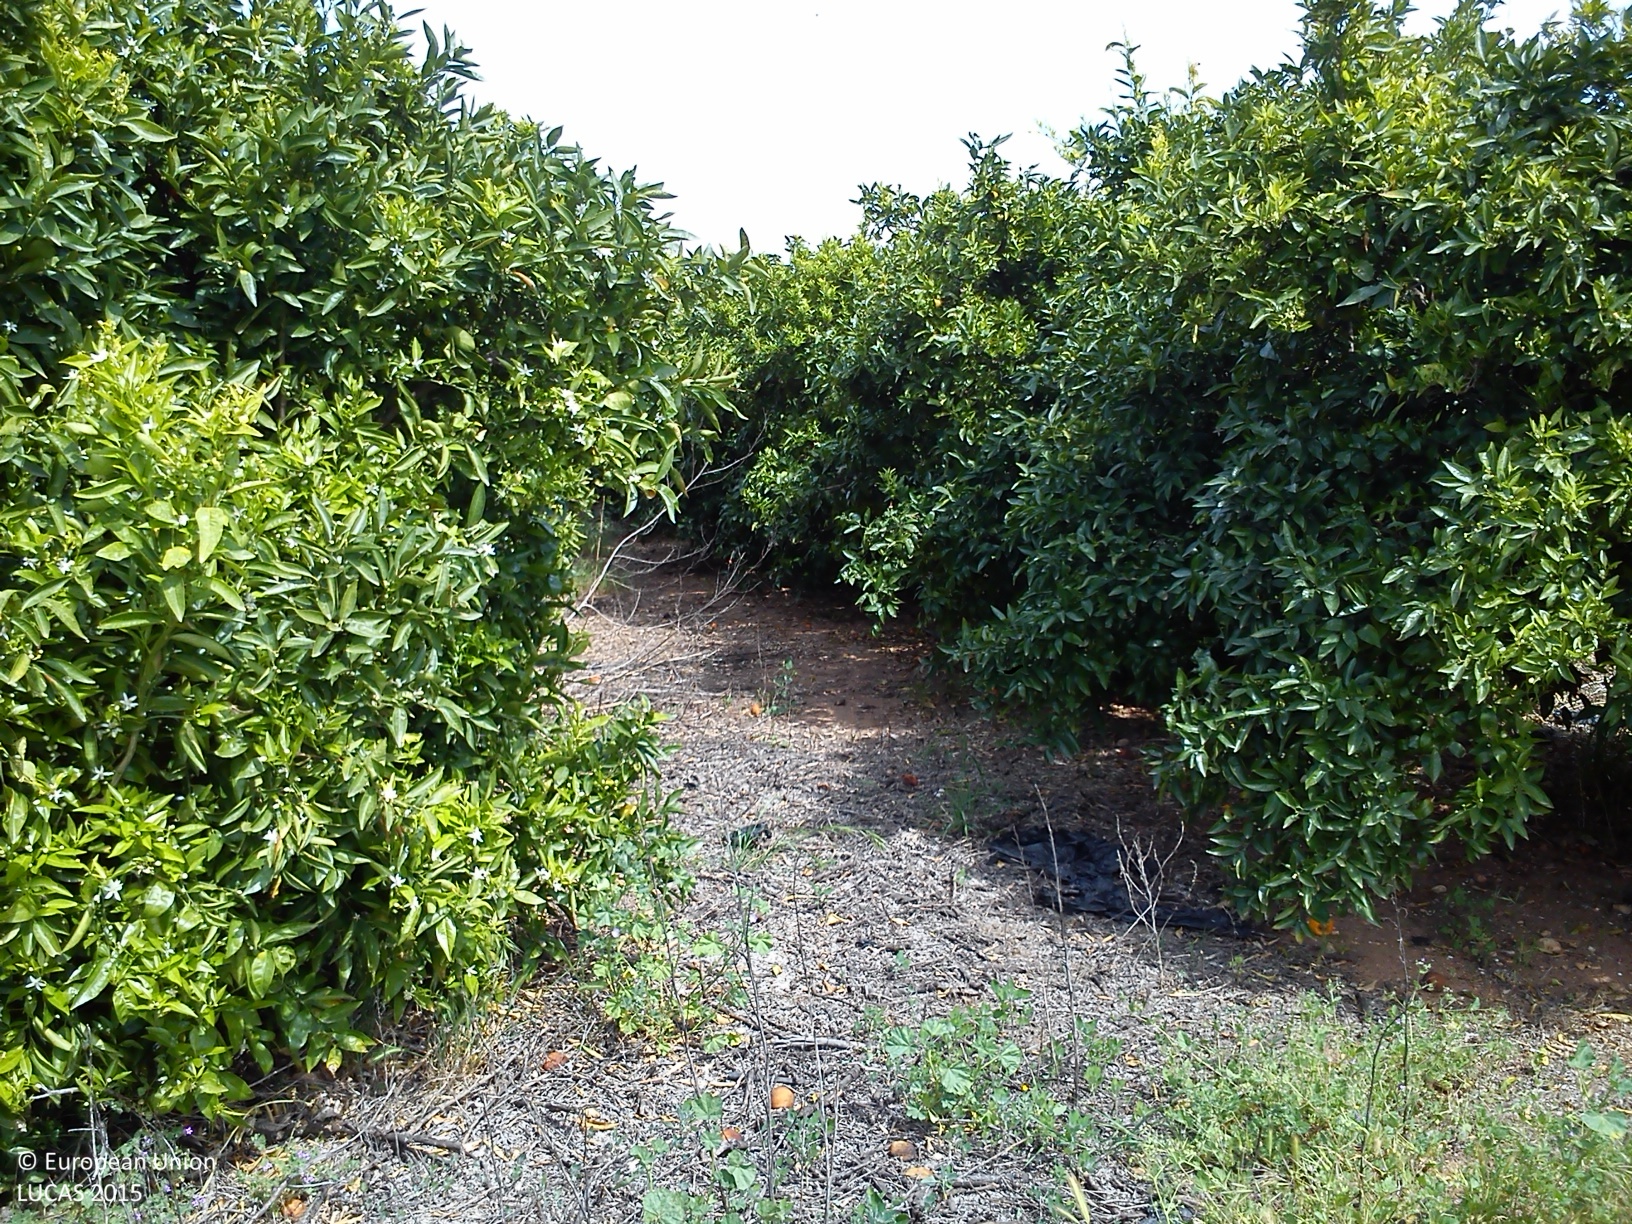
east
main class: Cropland
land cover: Oranges
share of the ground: > 75 %
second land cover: Spontaneously vegetated surfaces
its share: < 10 %
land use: Agriculture (excluding fallow land and kitchen gardens)
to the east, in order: Oranges; Spontaneously vegetated surfaces; Tracks; Ditches and canals; Oranges; Ditches and canals; Oranges
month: April
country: ES
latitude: 39.3946
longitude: -0.6454
